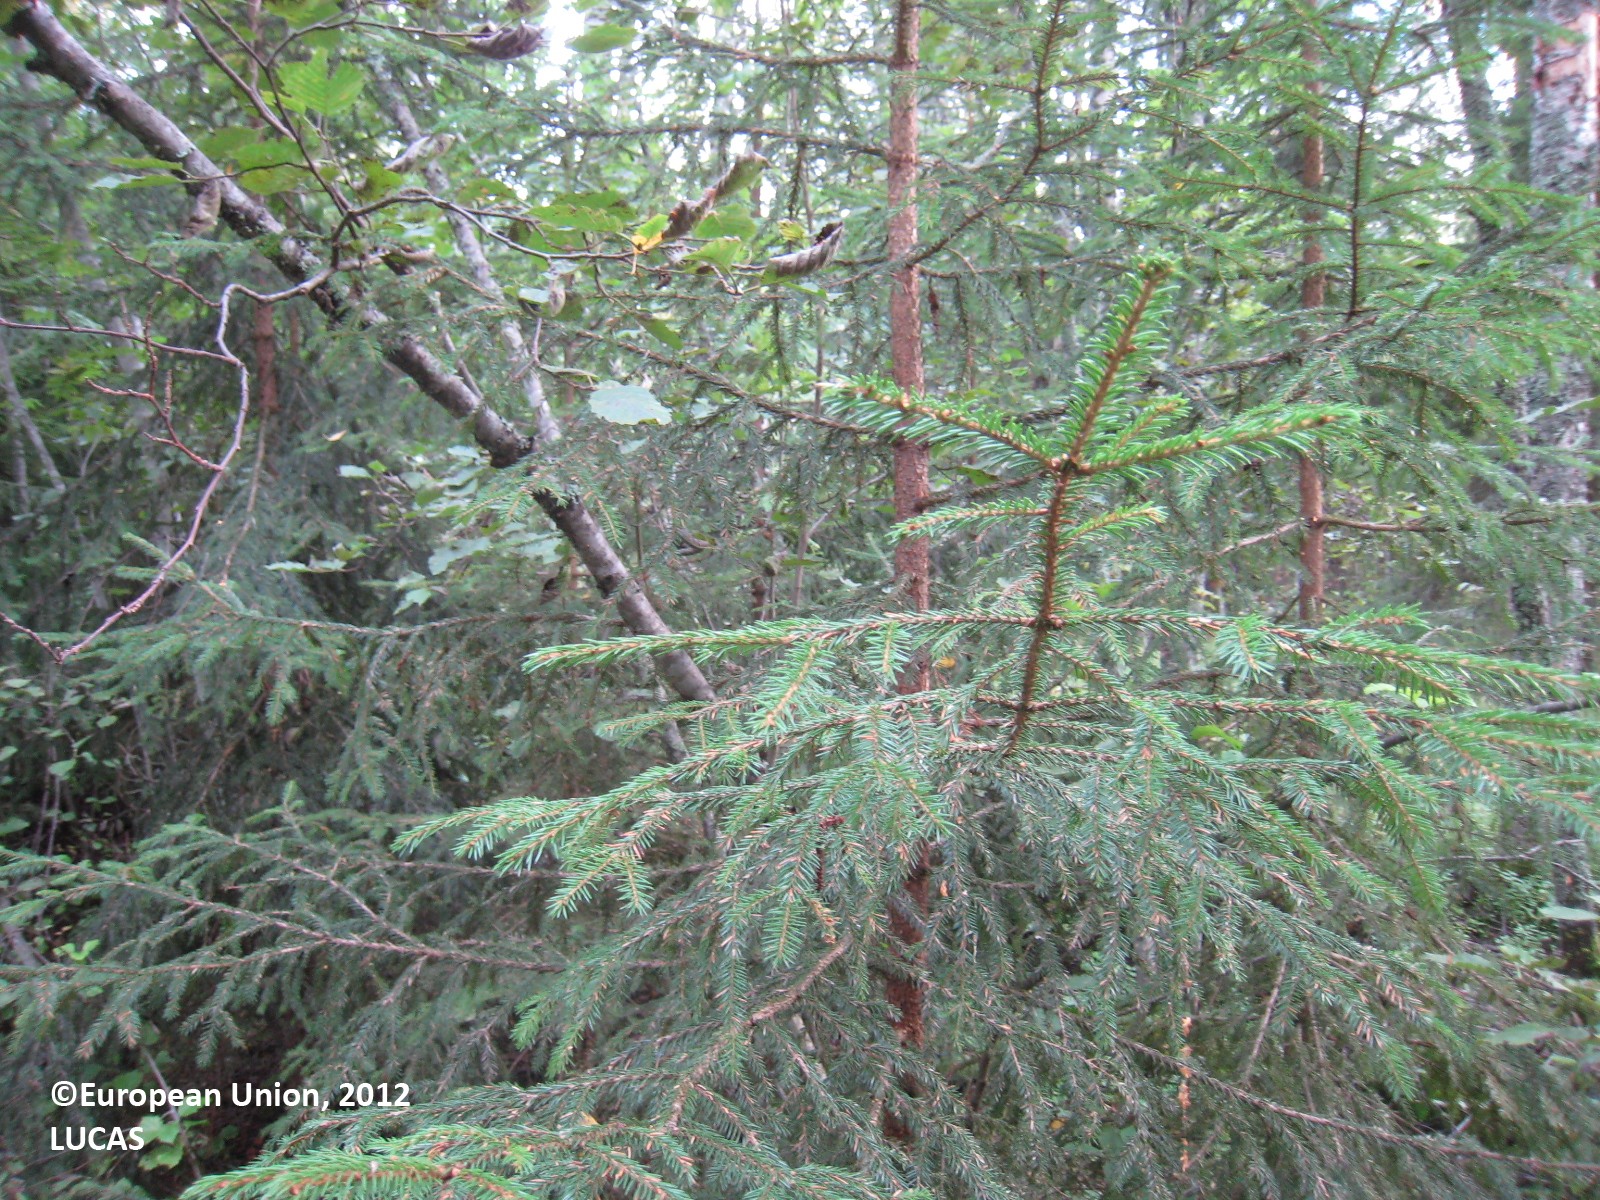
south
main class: Woodland
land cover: Spruce dominated mixed woodland
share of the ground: > 75 %
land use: Forestry
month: September
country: FI
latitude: 62.9541
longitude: 26.6361
